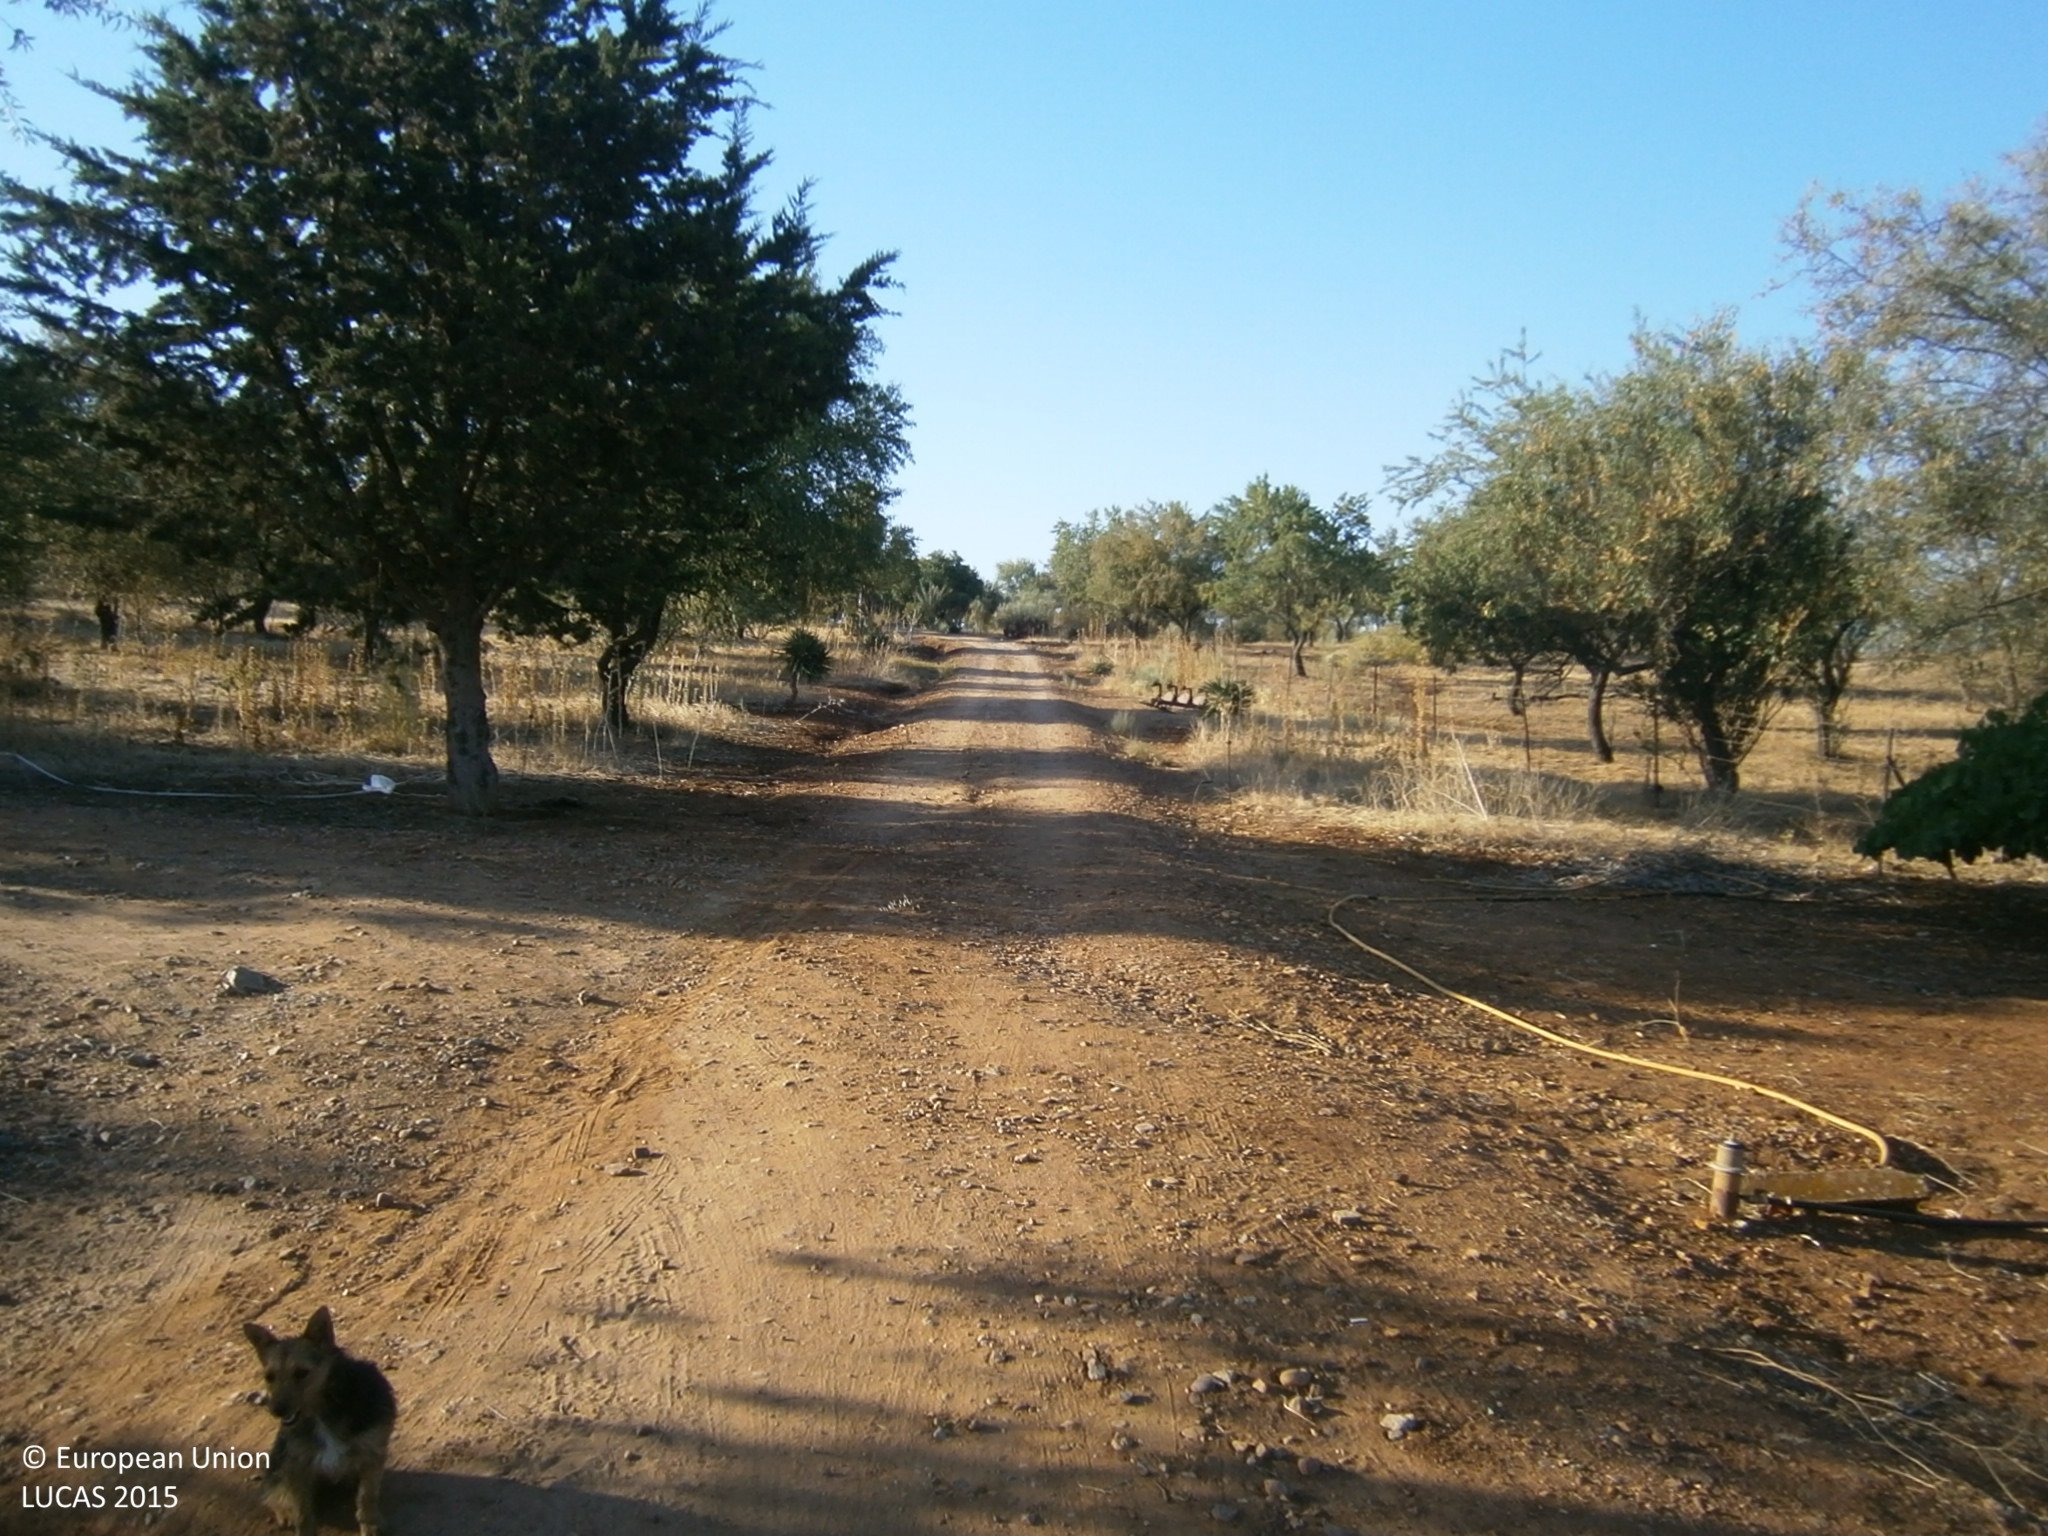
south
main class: Cropland
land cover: Nuts trees
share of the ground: 10 - 25 %
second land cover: Spontaneously vegetated surfaces
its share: 50 - 75 %
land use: Agriculture (excluding fallow land and kitchen gardens)
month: June
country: ES
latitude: 38.7955
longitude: -6.8644
